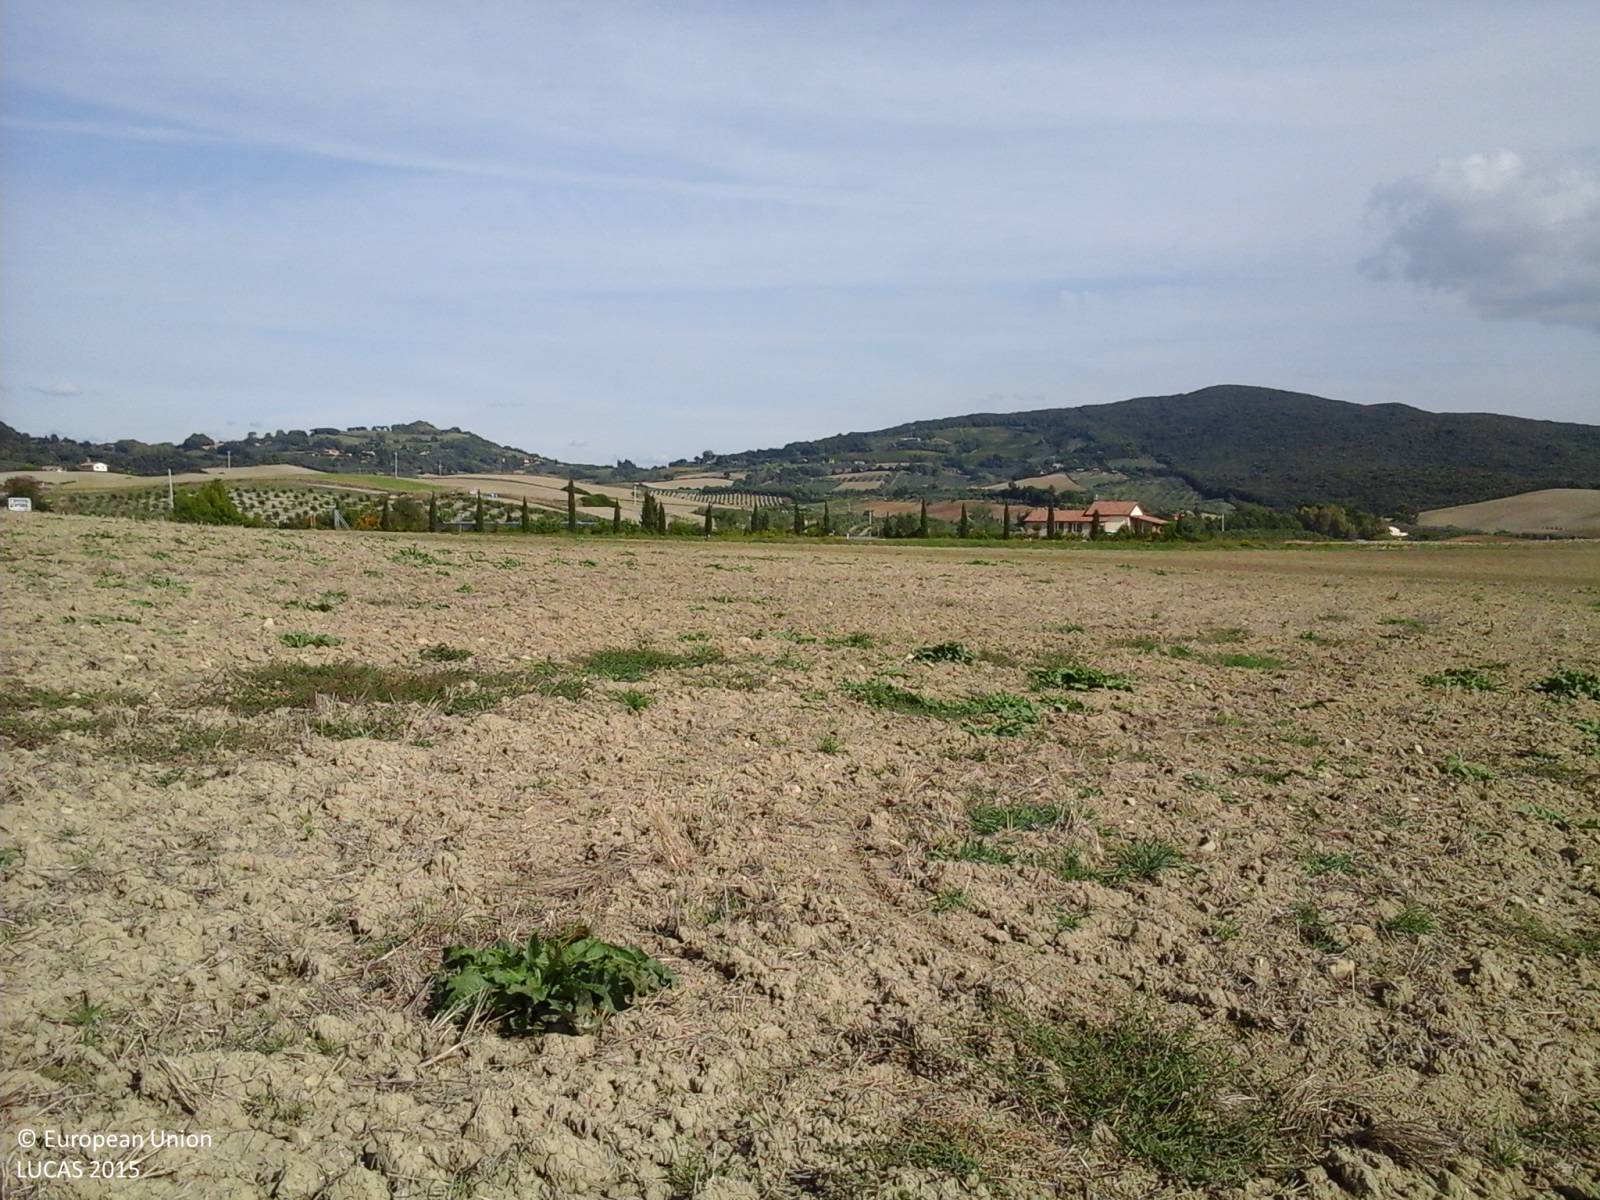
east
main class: Cropland
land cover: Durum wheat
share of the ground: < 10 %
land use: Agriculture (excluding fallow land and kitchen gardens)
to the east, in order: Durum wheat; Ditches and canals; Durum wheat; Ditches and canals; Durum wheat; Grass margins; Ditches and canals; Grass margins; Paved roads, cycling and walking lanes; Grass margins; Ditches and canals; Grass margins; Abandoned hedges; Olive groves; Artificial constructions in urban areas
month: October
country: IT
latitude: 43.2842
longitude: 10.6021
